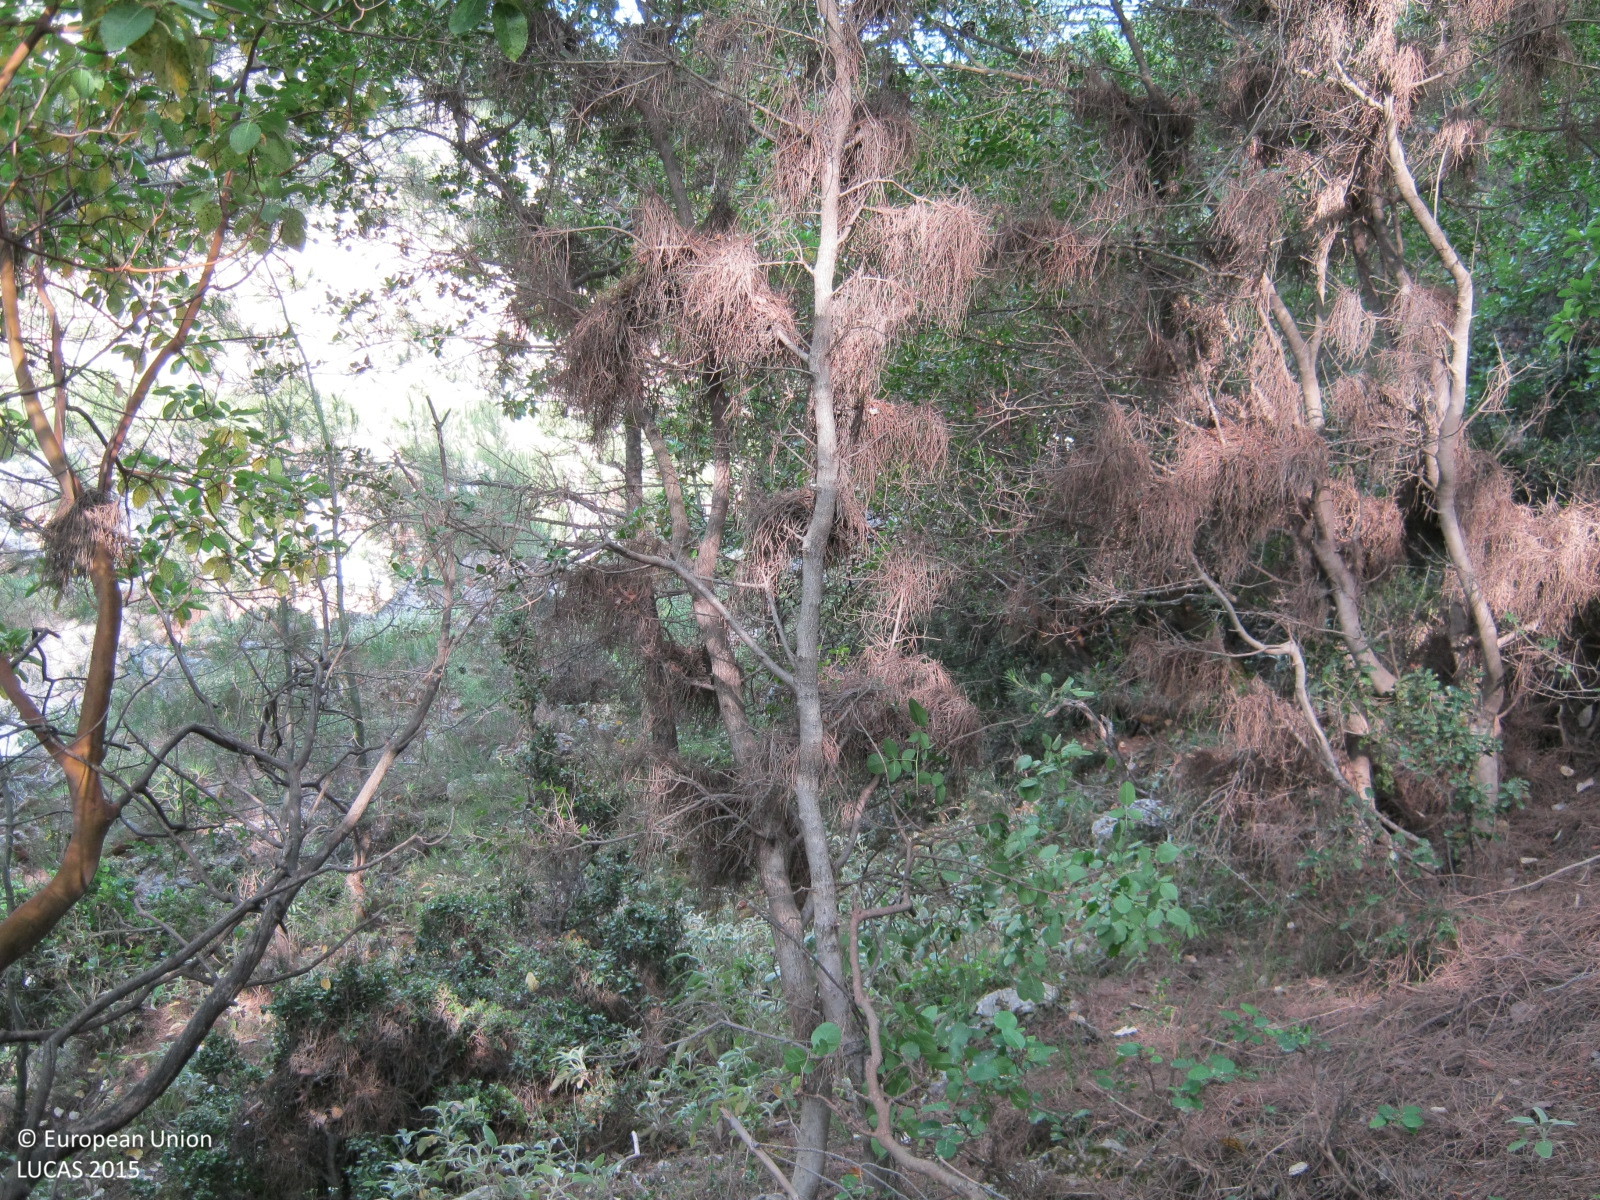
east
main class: Woodland
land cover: Other mixed woodland
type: coniferous forest of the mediterranean region
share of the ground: > 75 %
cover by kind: coniferous forest trees 55 %, broadleaved forest trees 25 %, shrubs 10 %, herbaceous plants 5 %, unconsolidated bare surface 5 %
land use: Semi-natural and natural areas not in use
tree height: > 5 m
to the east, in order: Other mixed woodland; Grass margins; Tracks; Grass margins; Electric lines; Shrubland without tree cover; Tracks; Shrubland with sparse tree cover; Shrubland without tree cover; Shrubland with sparse tree cover
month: June
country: GR
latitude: 35.3469
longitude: 23.7461
